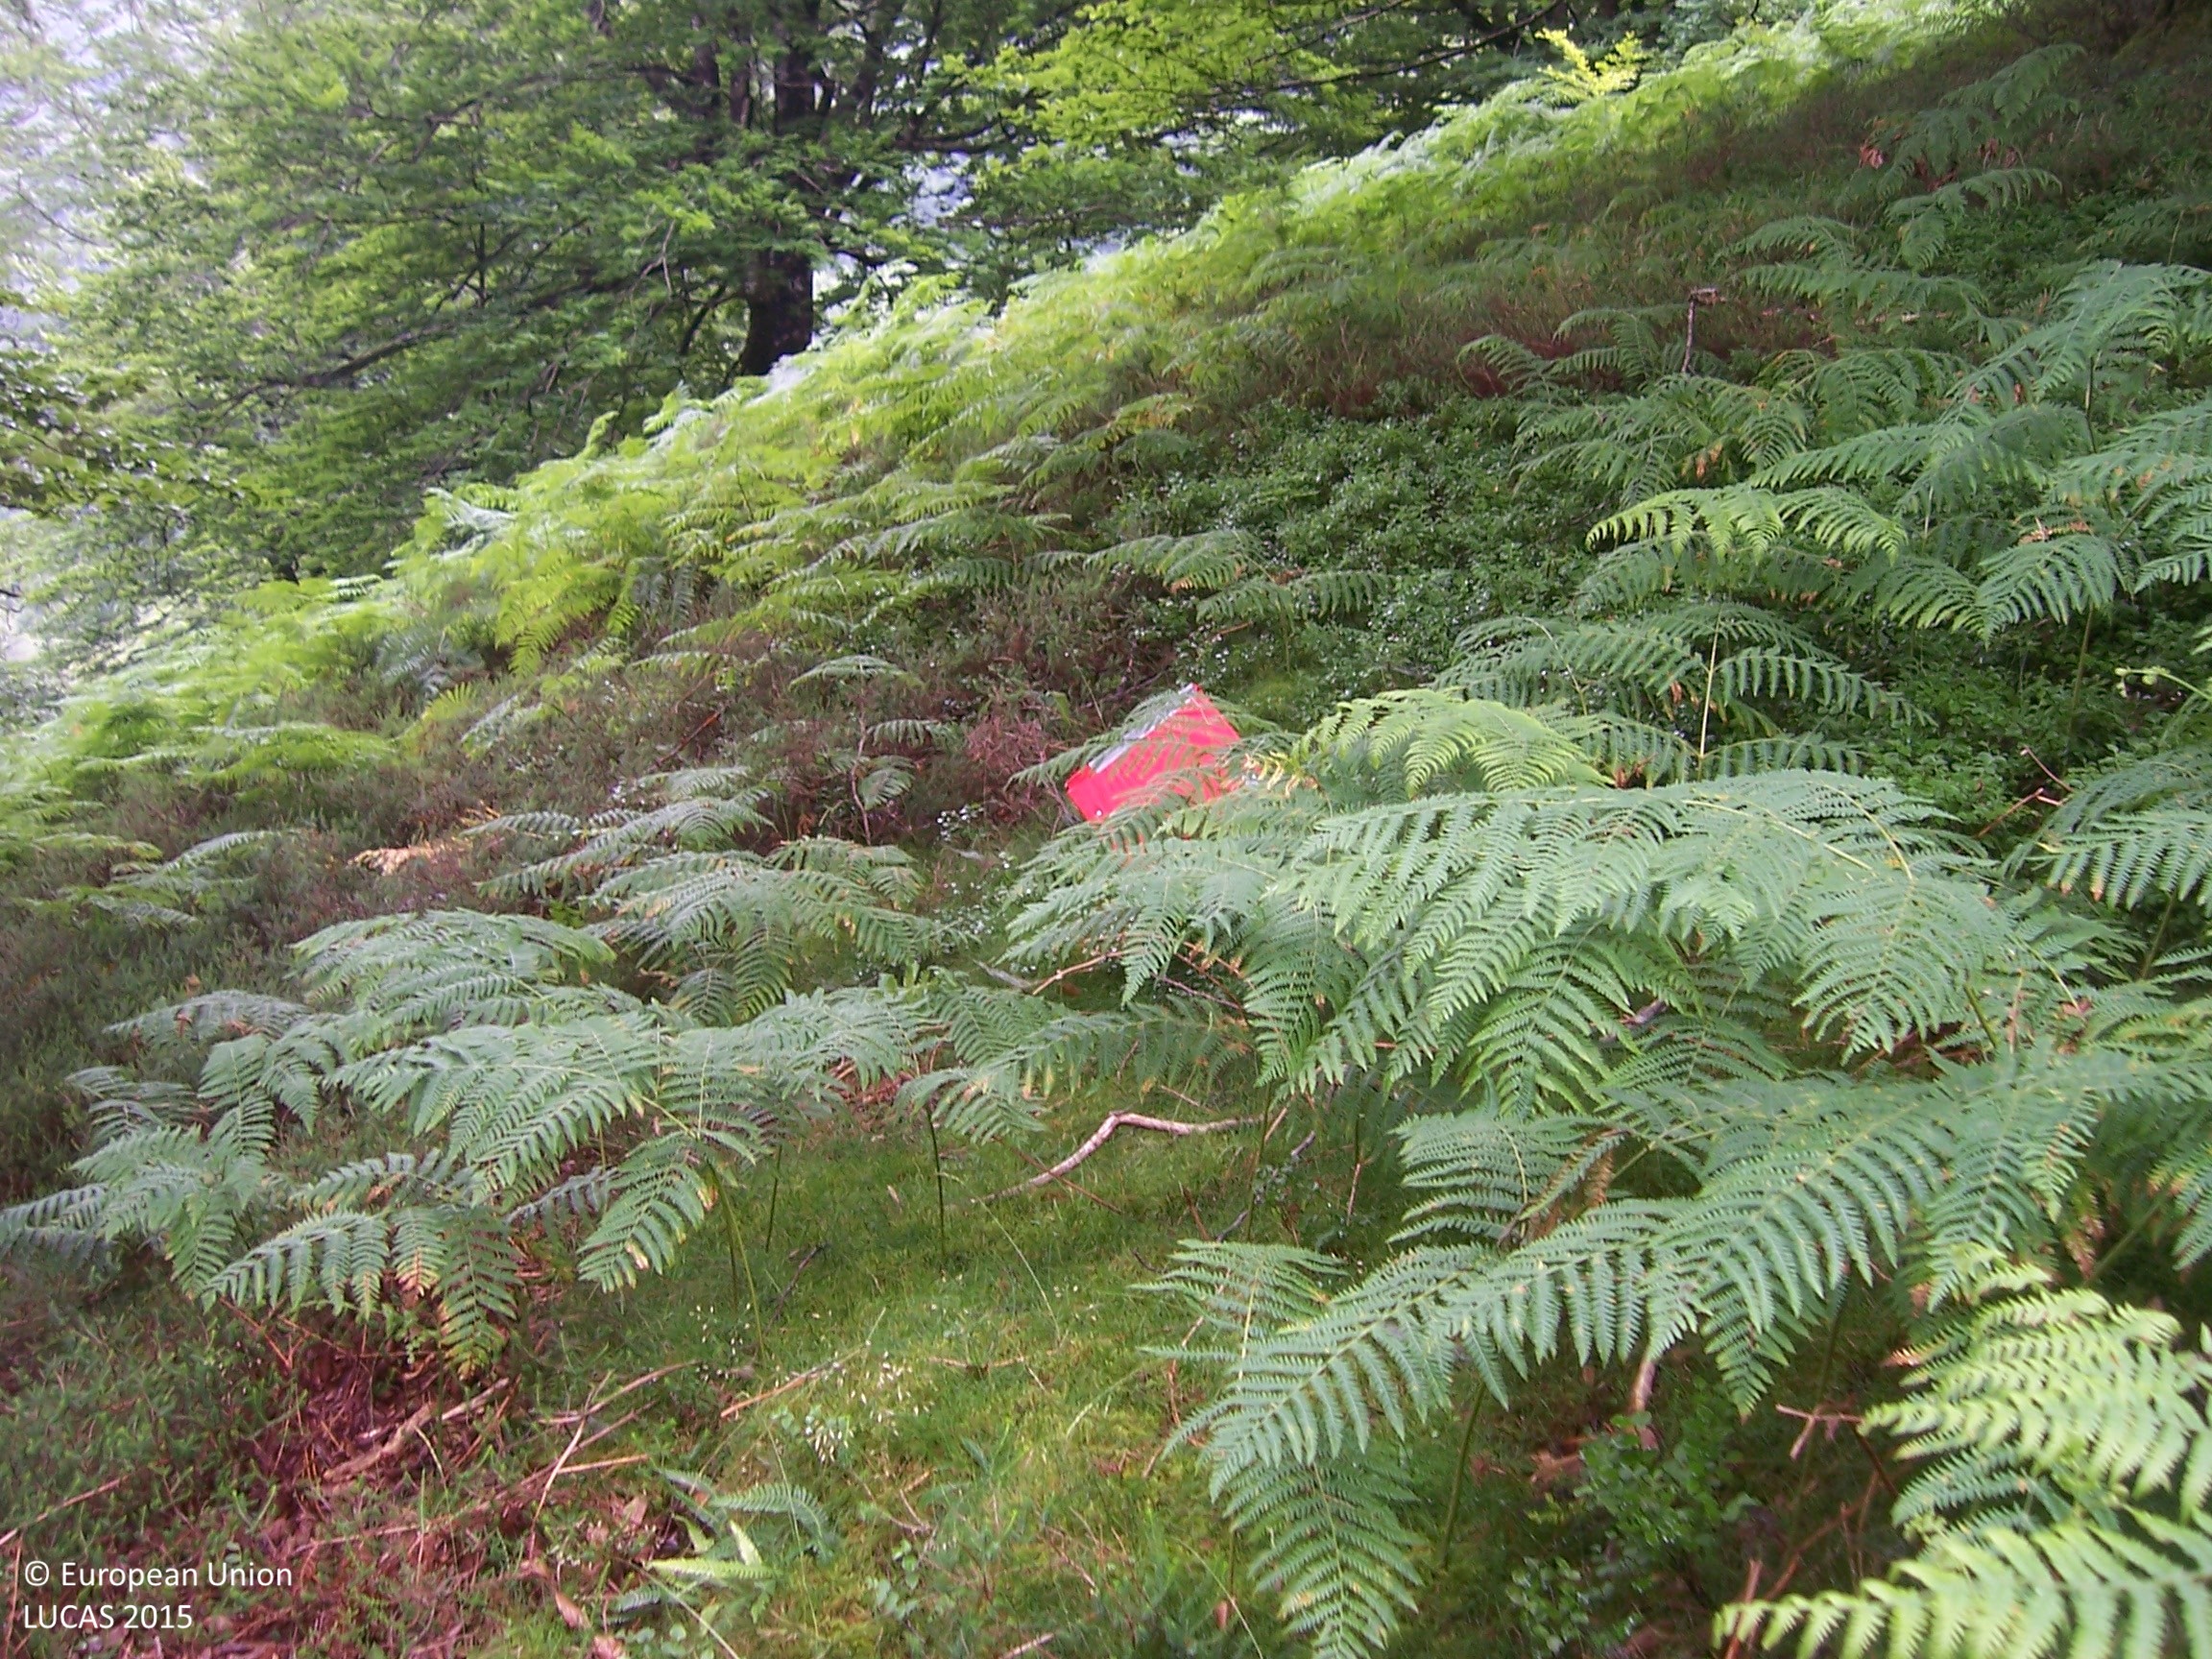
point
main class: Woodland
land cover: Broadleaved woodland
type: beech forest
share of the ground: > 75 %
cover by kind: broadleaved forest trees 90 %, herbaceous plants 10 %
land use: Forestry
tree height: > 5 m
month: July
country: ES
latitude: 43.0691
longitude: -1.5223
